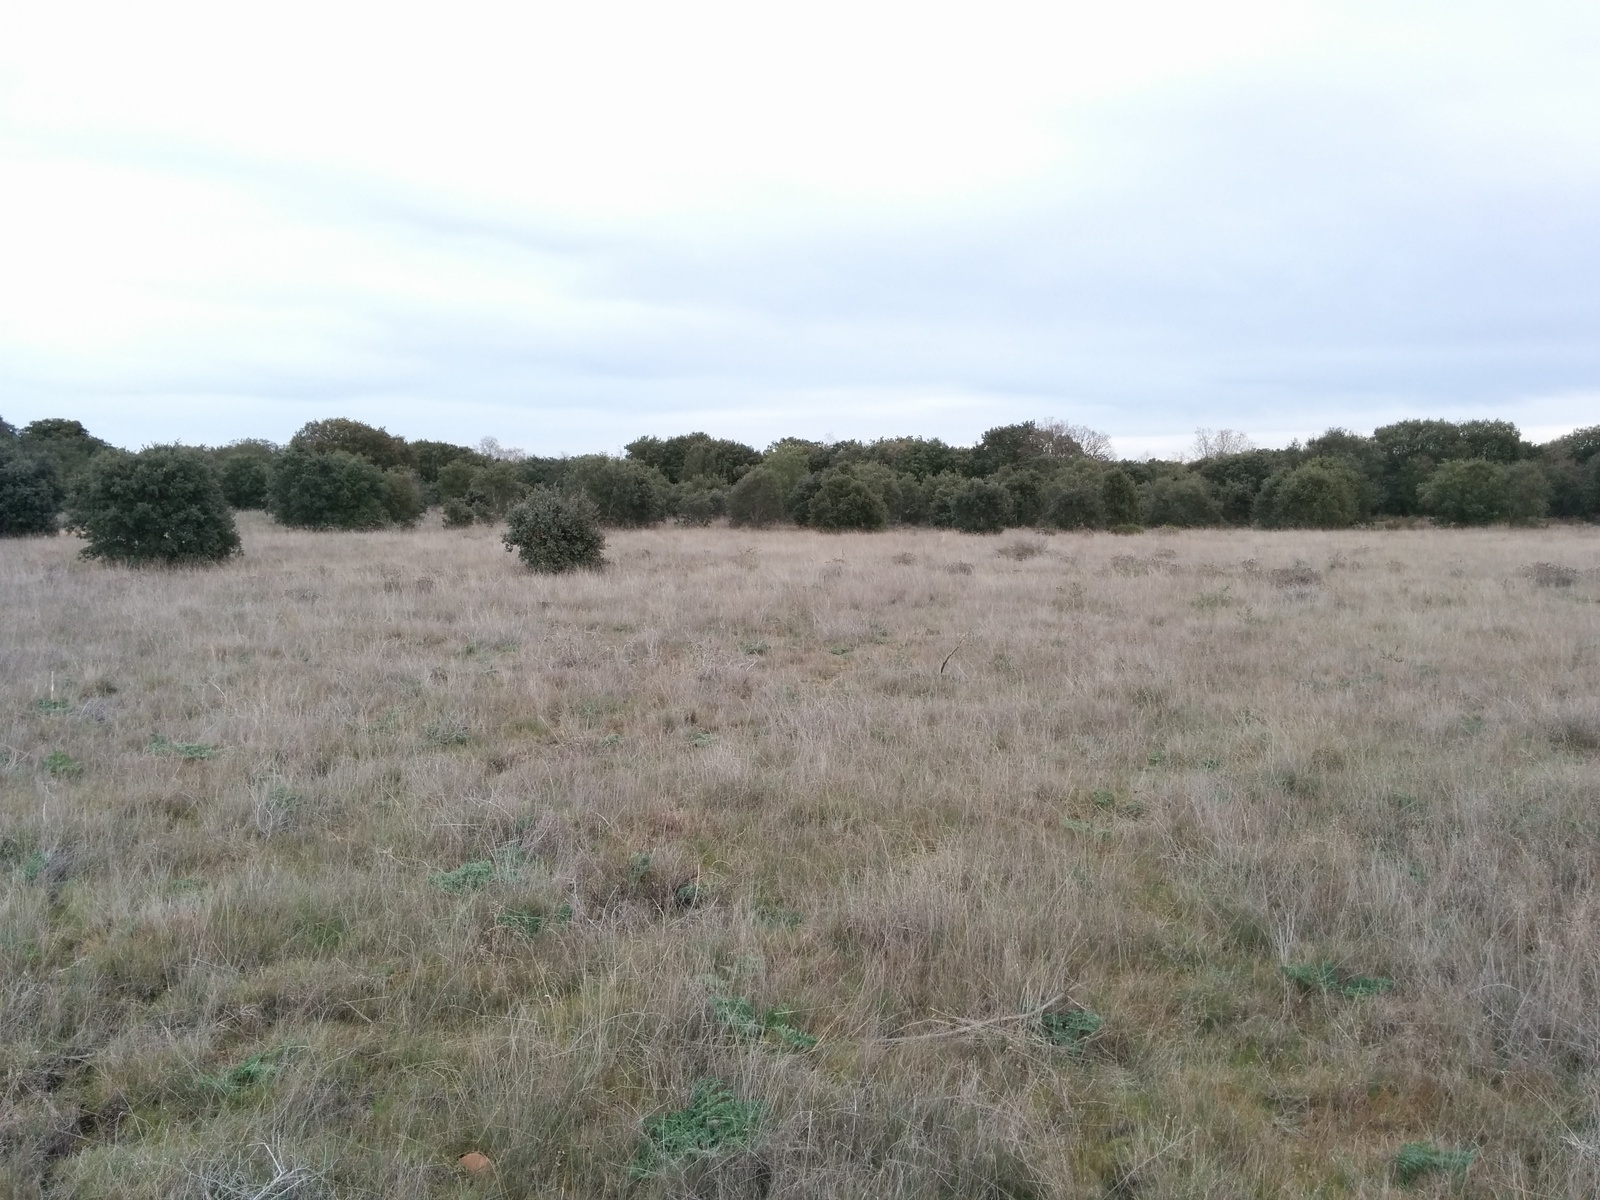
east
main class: Grassland
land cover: Grassland without tree/shrub cover
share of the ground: > 75 %
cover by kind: herbaceous plants 100 %
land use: Abandoned areas
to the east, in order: Grassland without tree/shrub cover; Grassland with sparse tree/shrub cover; Tracks; Broadleaved woodland; Shrubland with sparse tree cover; Broadleaved woodland
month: April
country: ES
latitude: 42.4532
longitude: -5.6738
